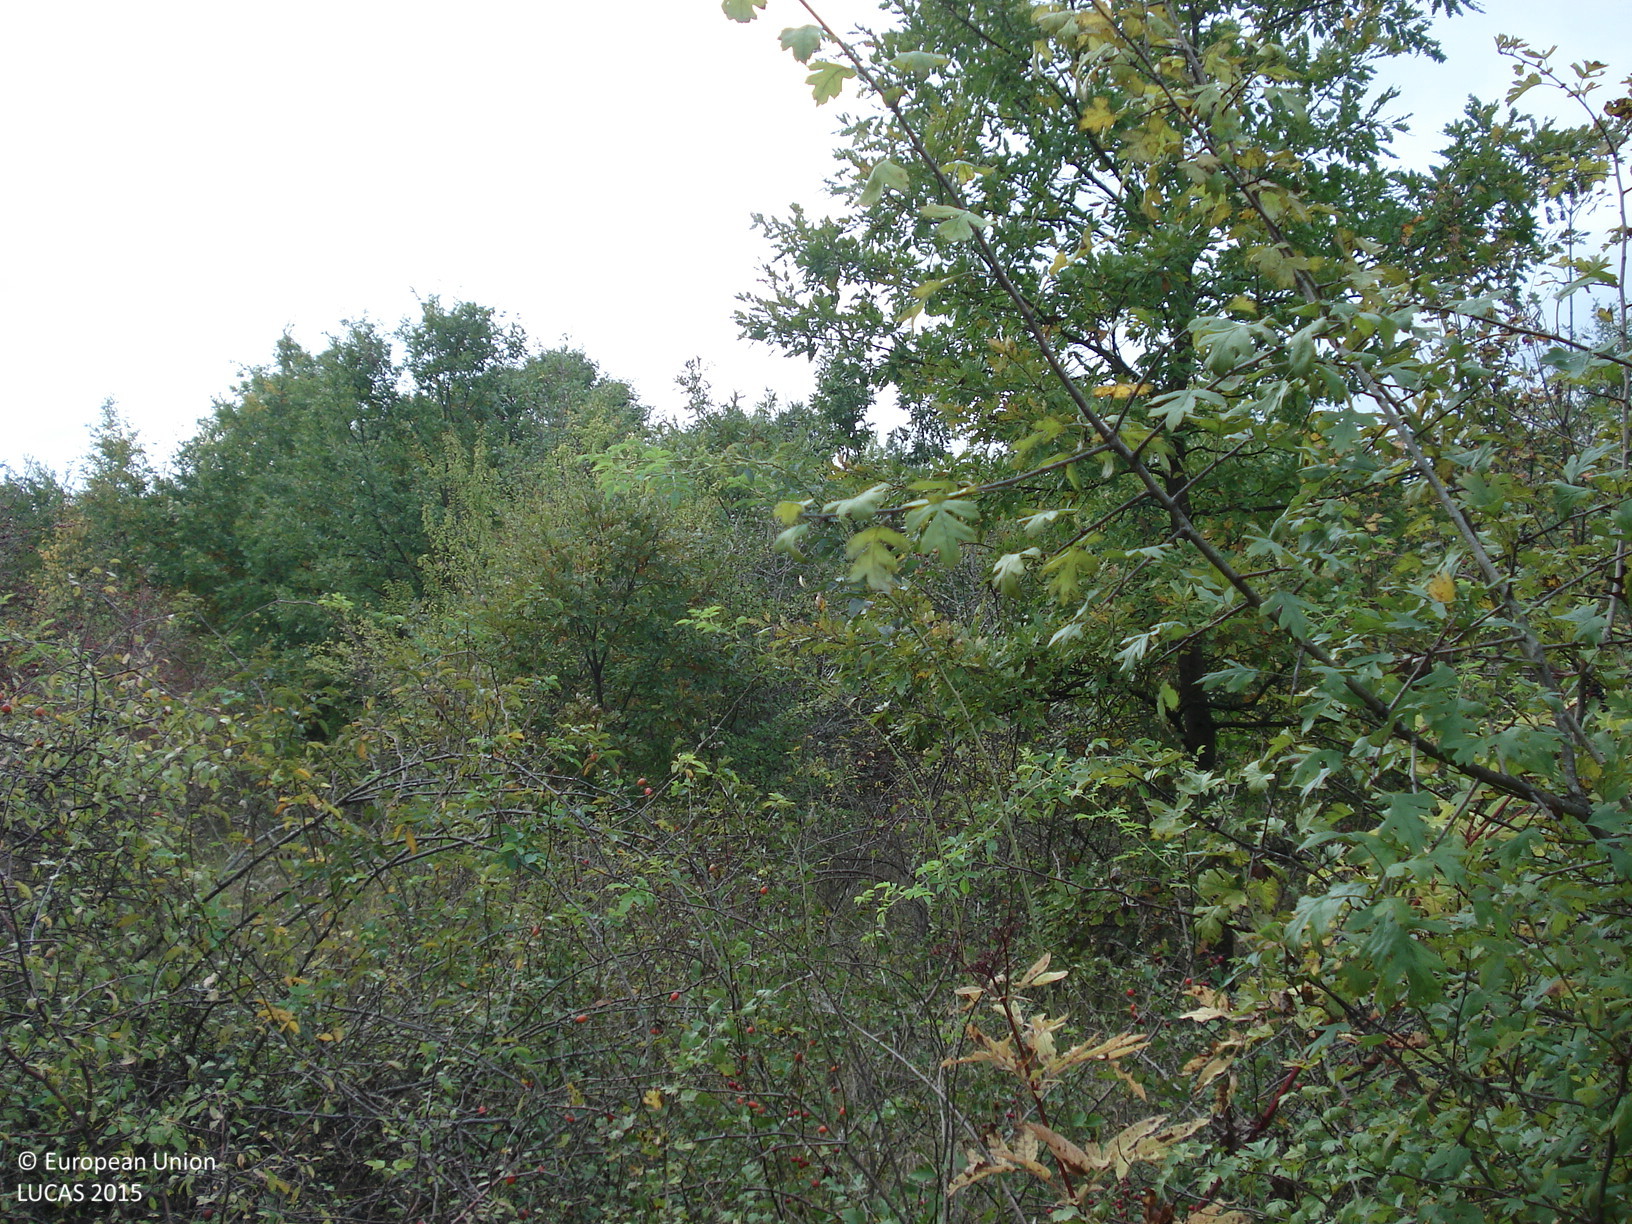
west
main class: Woodland
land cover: Broadleaved woodland
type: mesophytic deciduous forest
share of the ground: > 75 %
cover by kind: broadleaved forest trees 80 %, shrubs 10 %, herbaceous plants 10 %
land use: Forestry
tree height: > 5 m
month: October
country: BG
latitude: 42.9928
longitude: 25.7439
